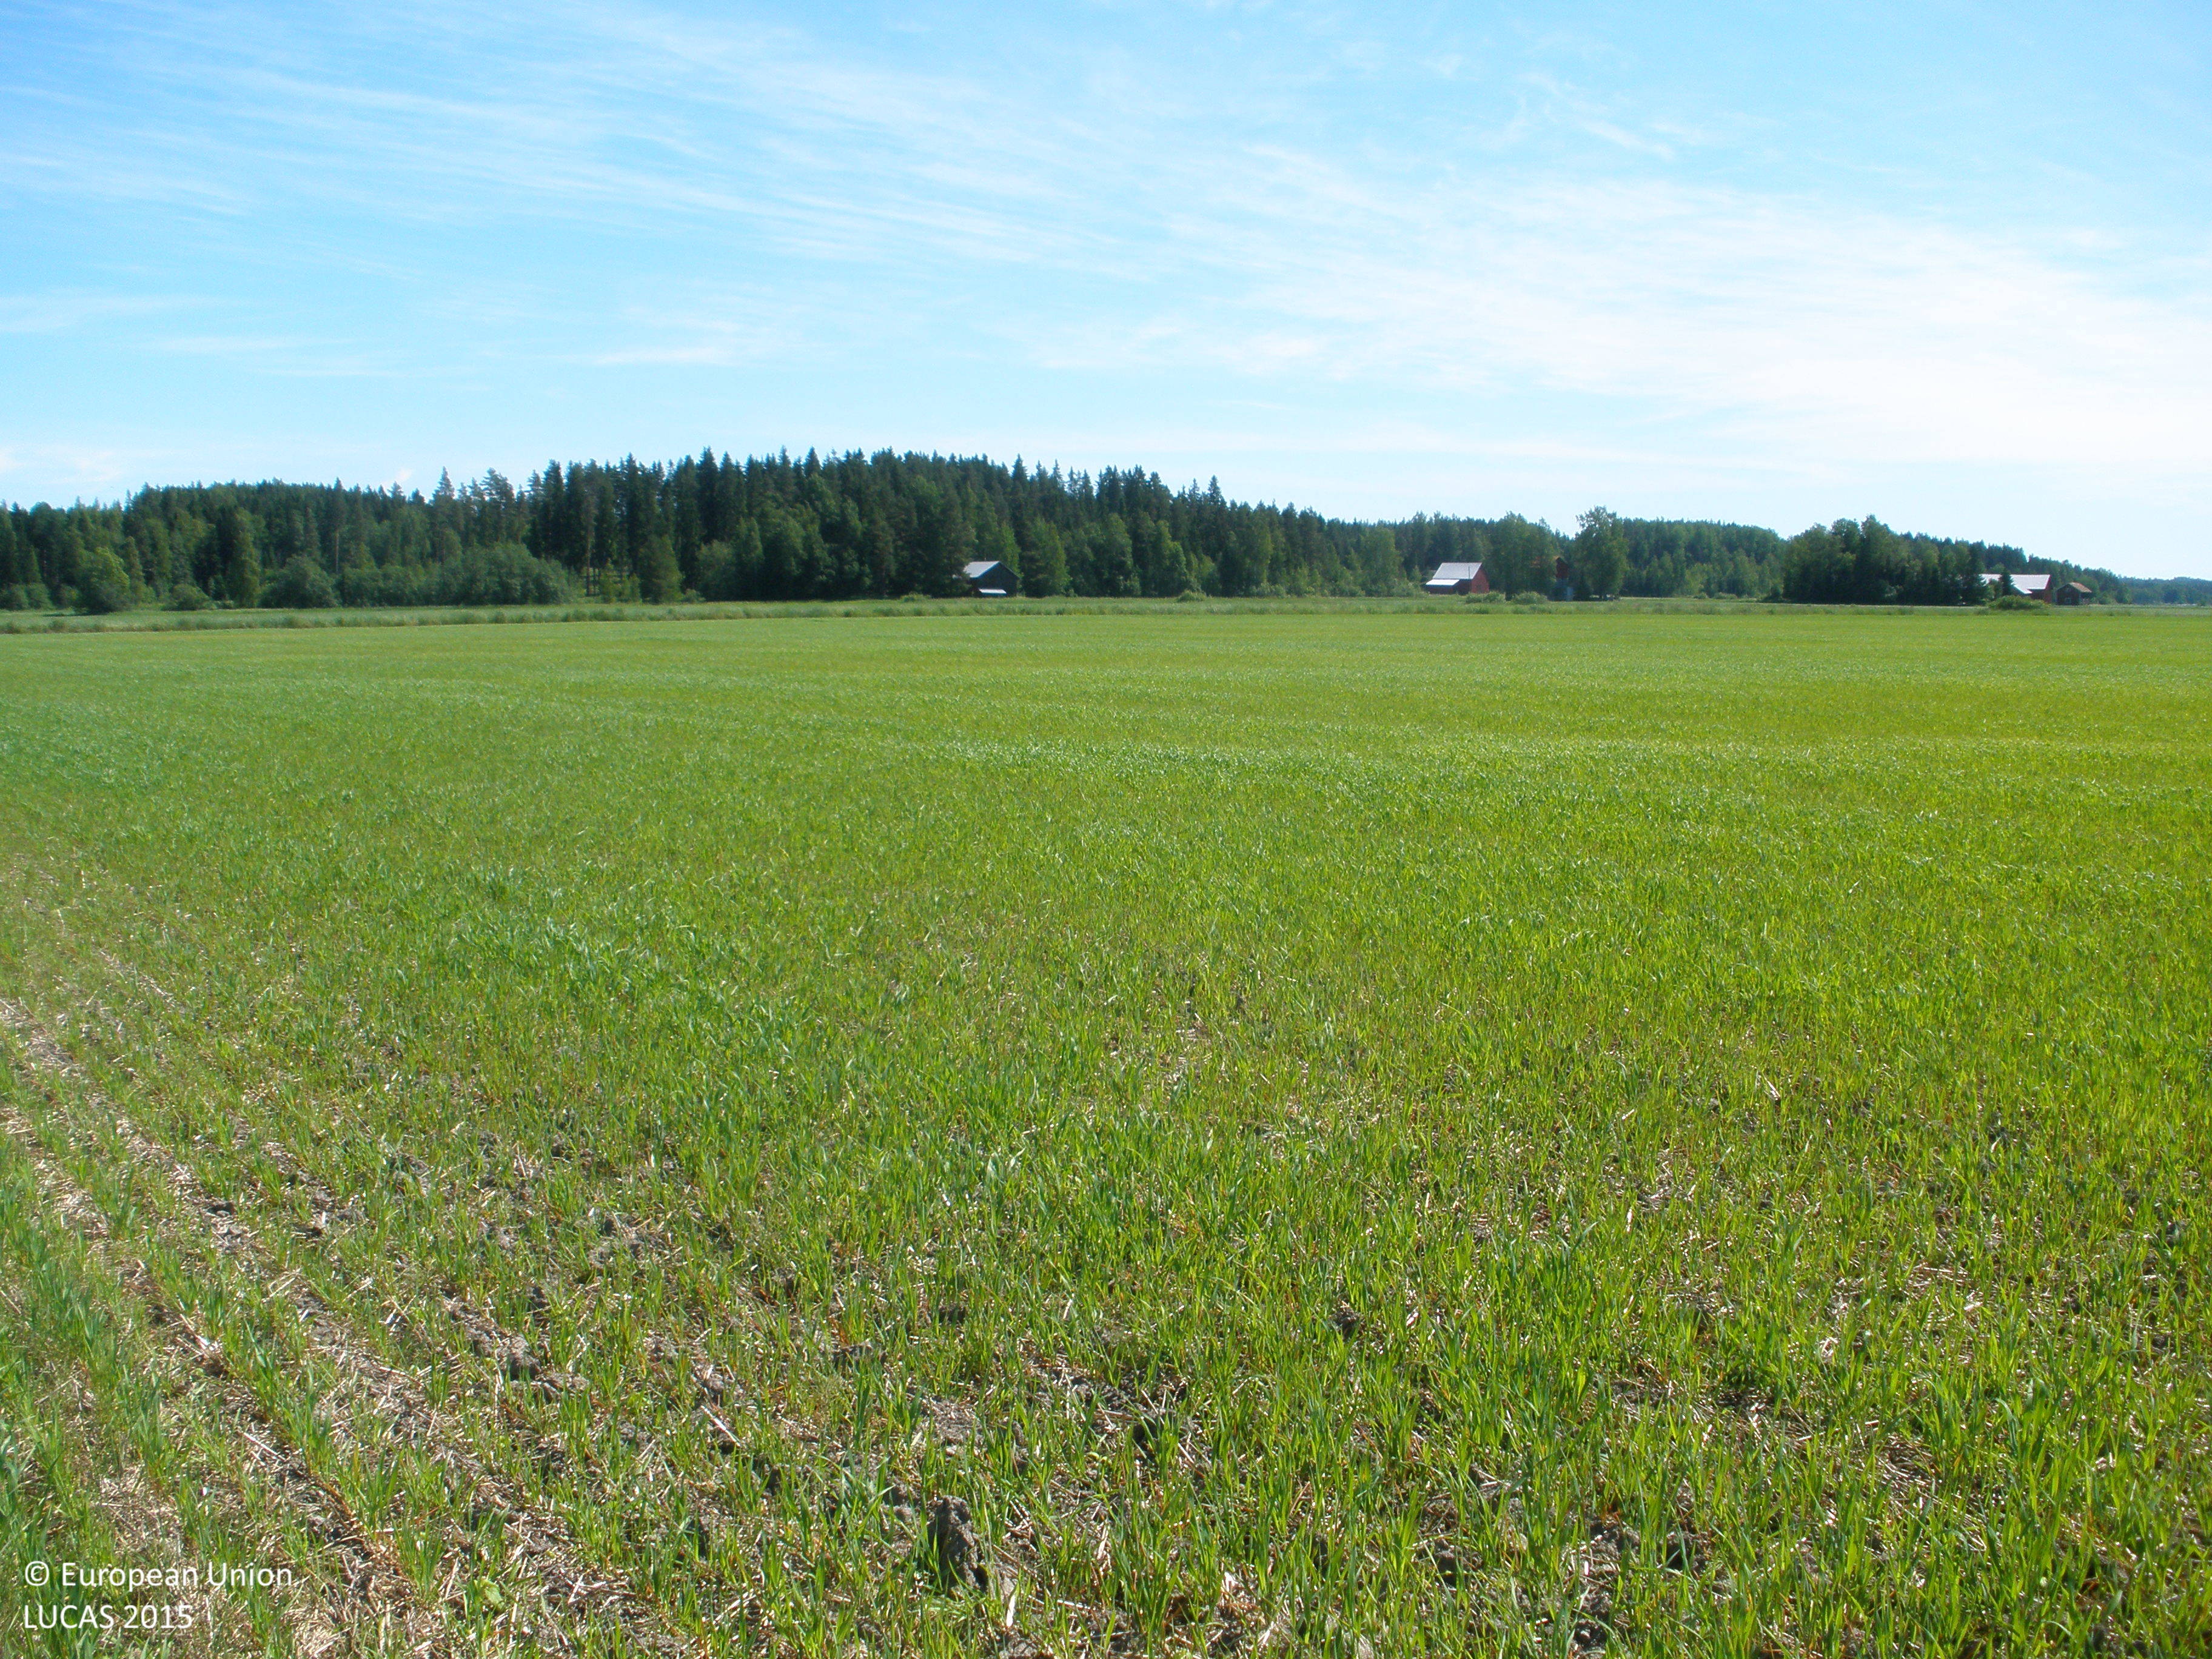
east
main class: Cropland
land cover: Oats
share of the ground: 25 - 50 %
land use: Agriculture (excluding fallow land and kitchen gardens)
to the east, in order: Oats; Grass margins; Ditches and canals; Grass margins; Oats
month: July
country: FI
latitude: 61.0857
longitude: 23.6761
